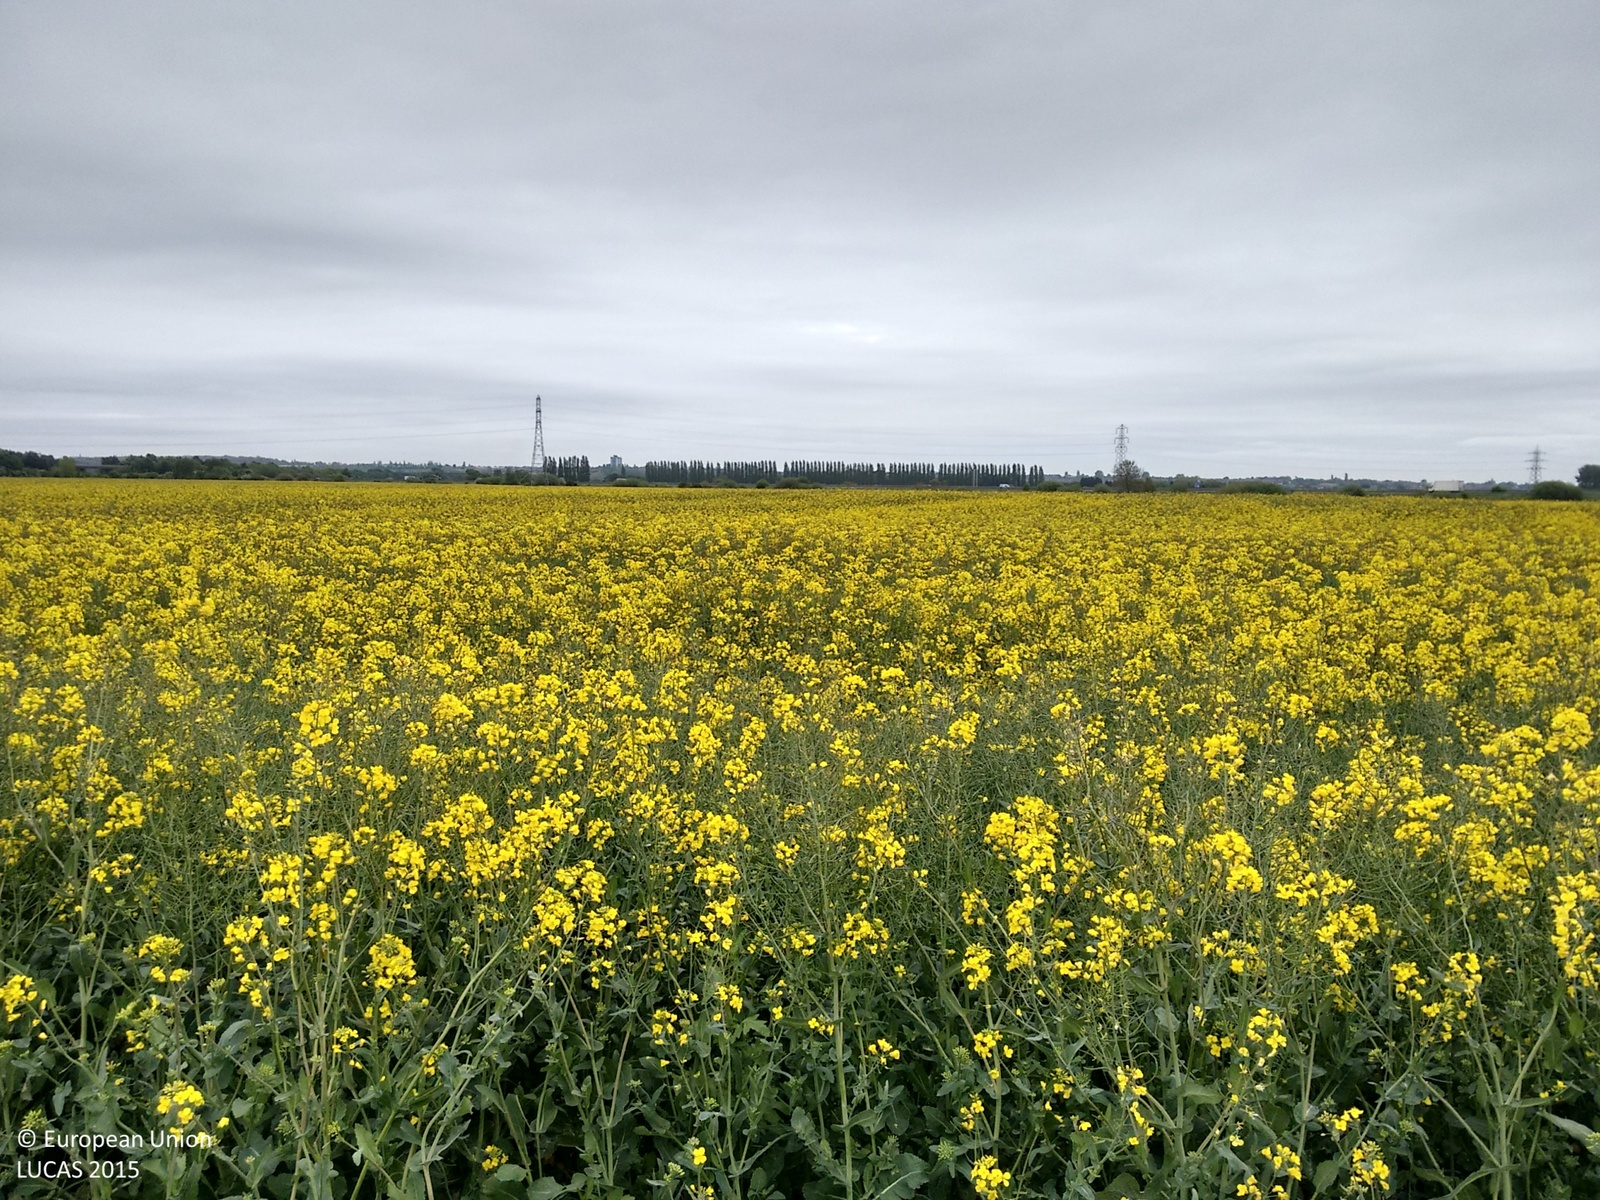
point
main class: Cropland
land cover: Rape and turnip rape
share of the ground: > 75 %
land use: Agriculture (excluding fallow land and kitchen gardens)
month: May
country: GB
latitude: 53.5602
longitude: -0.7132
